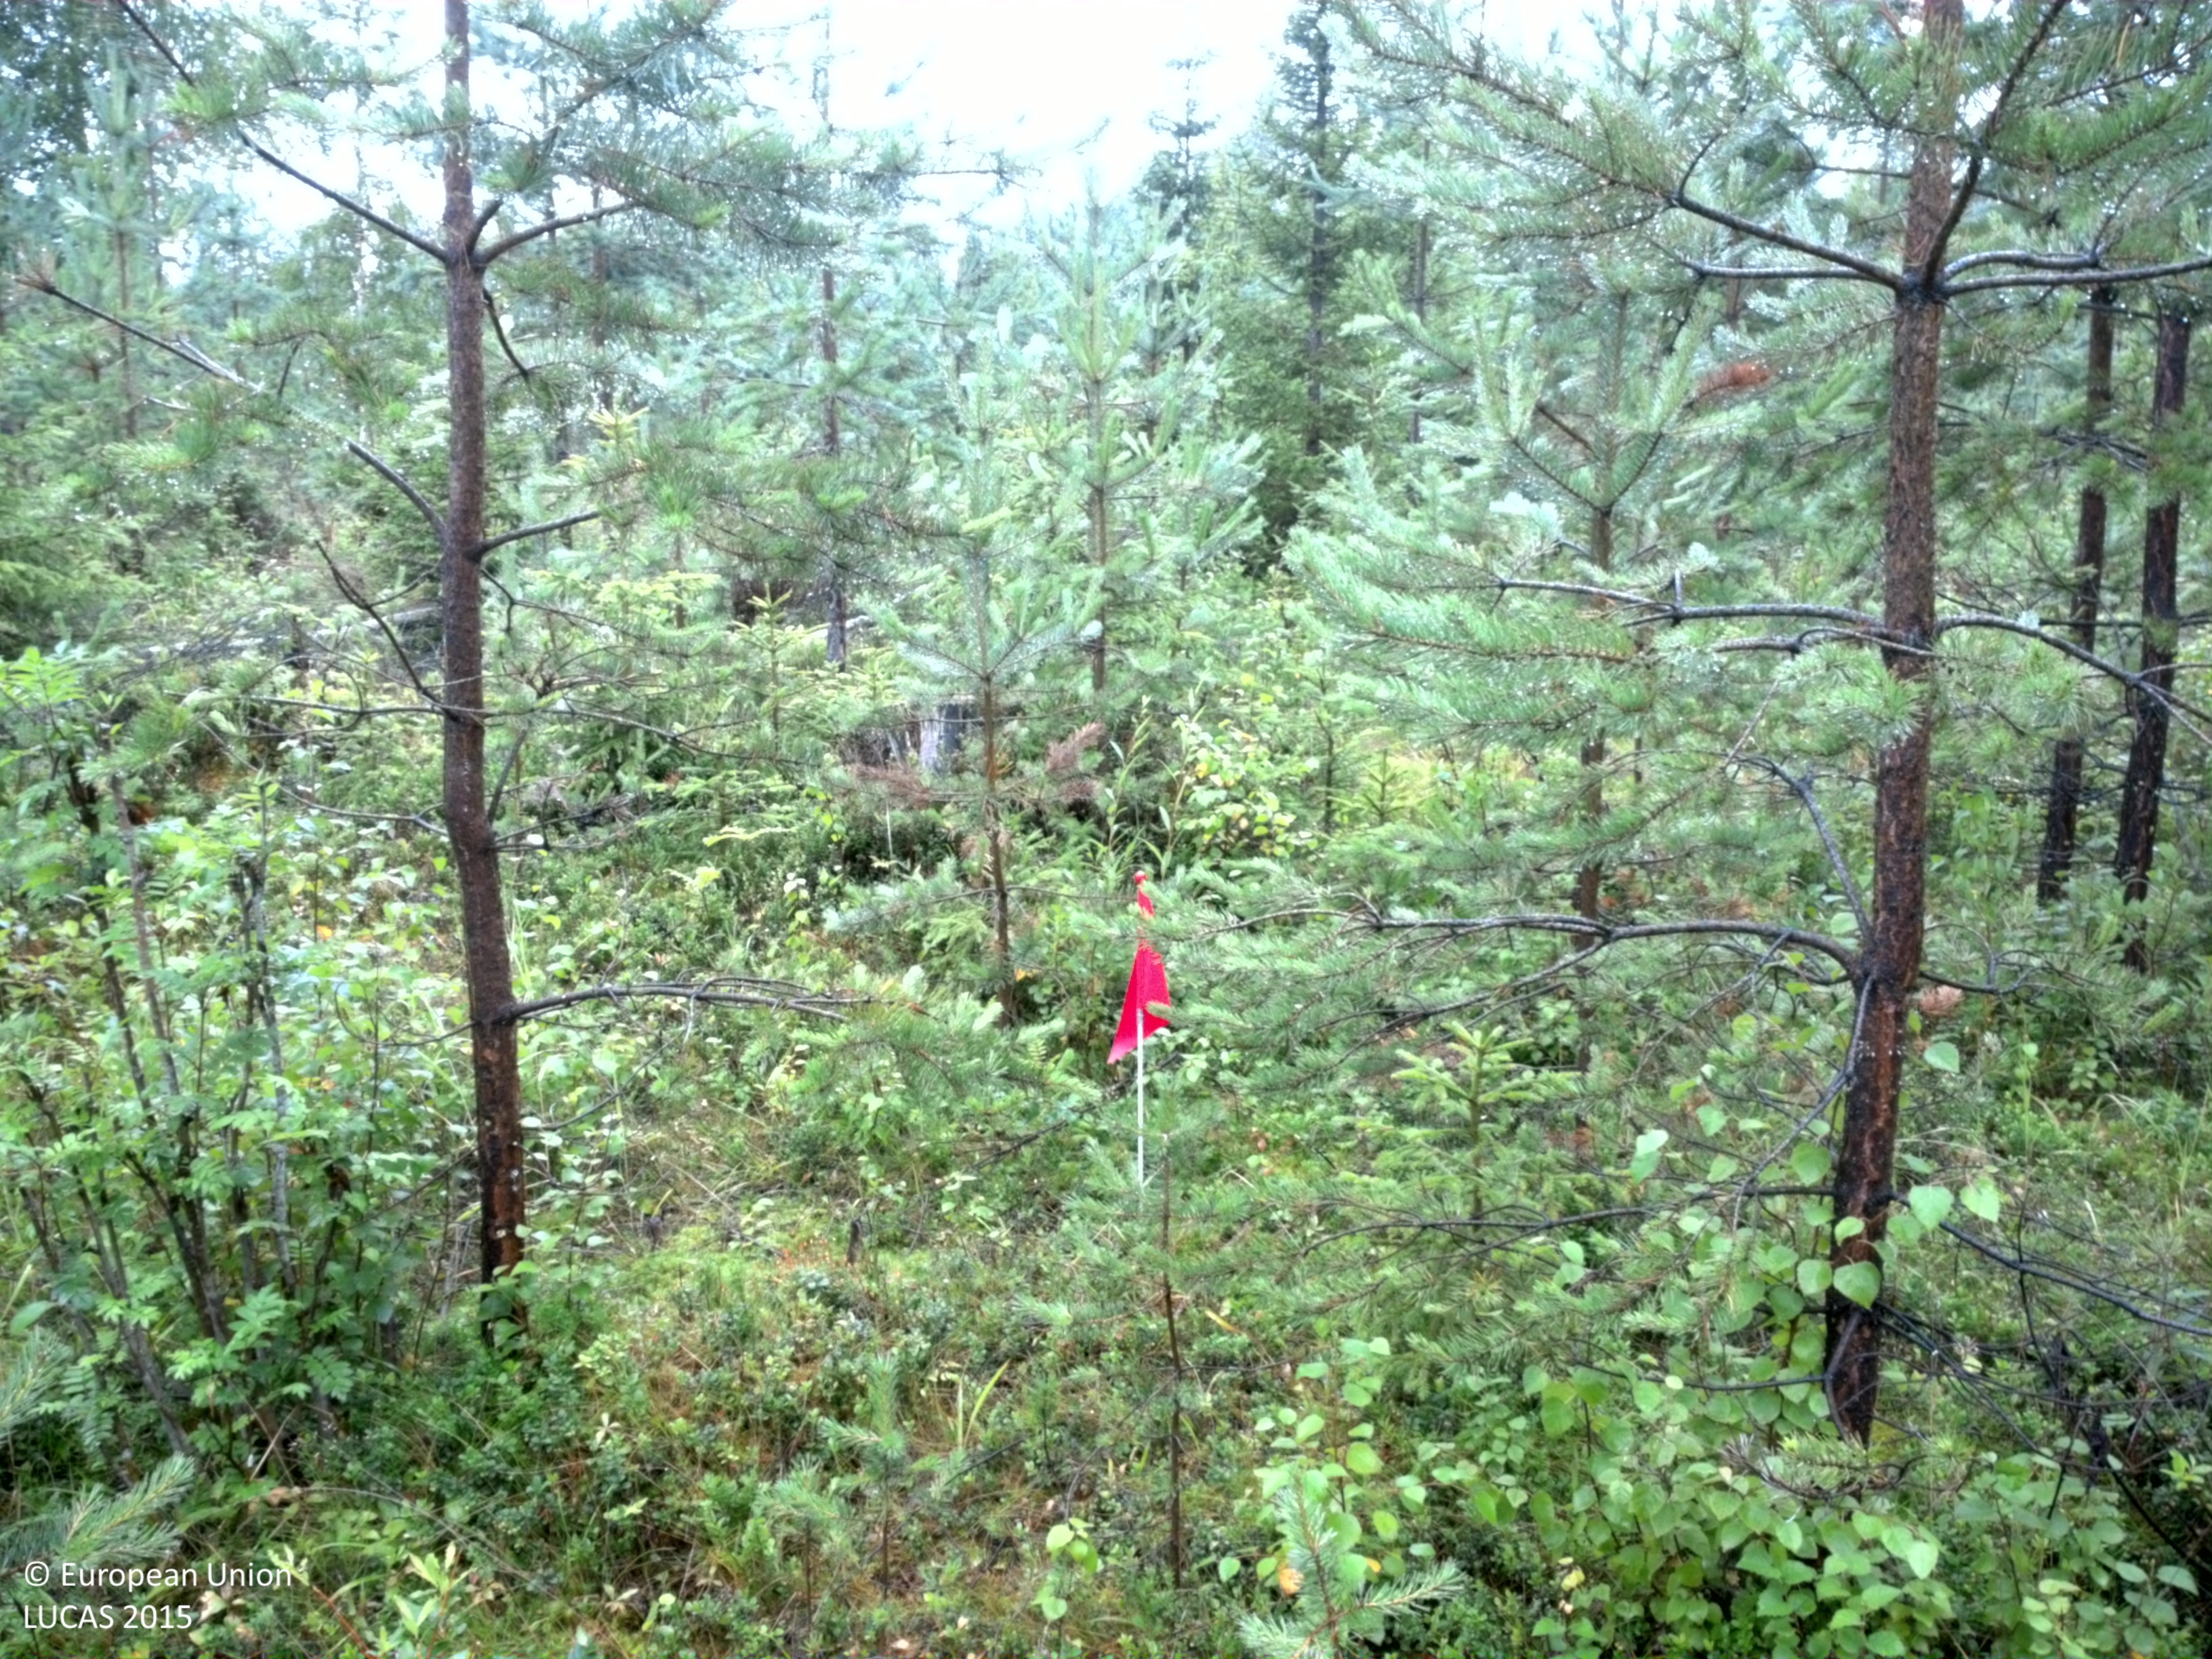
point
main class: Woodland
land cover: Pine dominated mixed woodland
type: boreal forest
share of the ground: 50 - 75 %
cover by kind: coniferous forest trees 45 %, shrubs 25 %, broadleaved forest trees 15 %, herbaceous plants 15 %
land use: Forestry
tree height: > 5 m
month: August
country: SE
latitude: 64.6947
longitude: 20.9446
